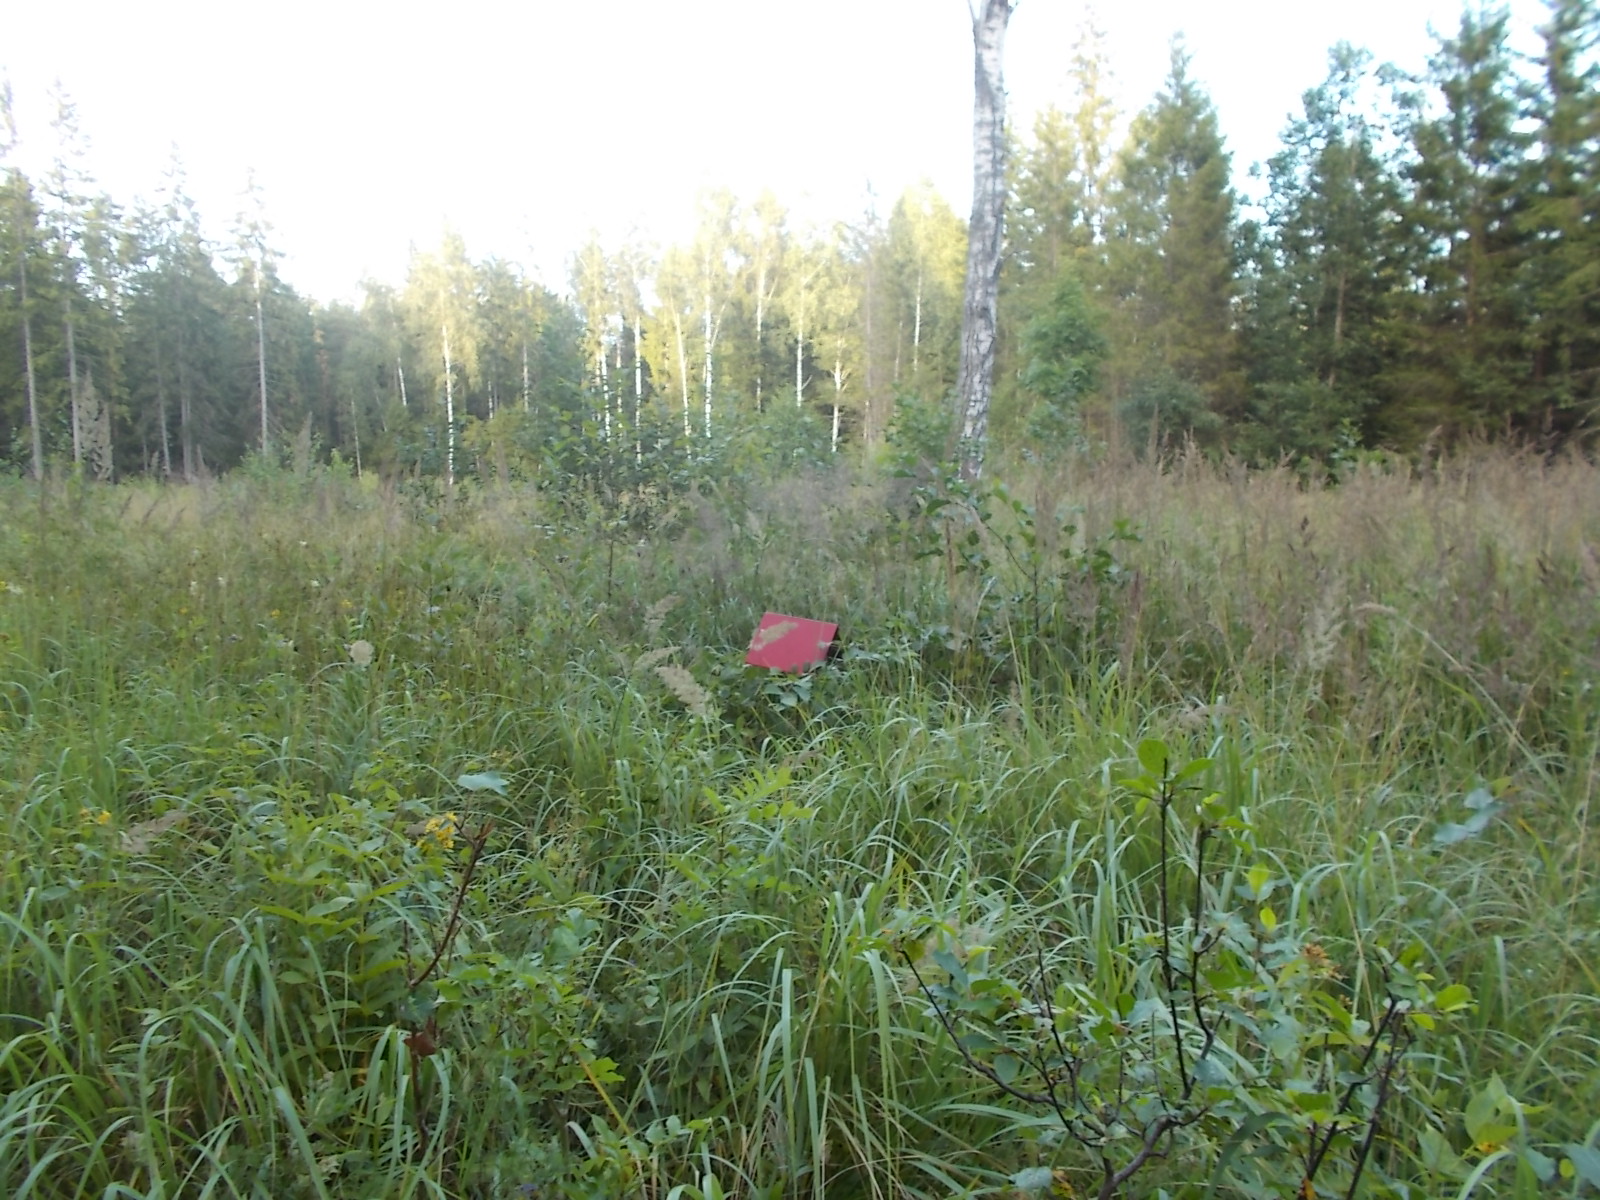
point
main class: Grassland
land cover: Grassland with sparse tree/shrub cover
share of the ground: > 75 %
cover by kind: herbaceous plants 90 %, broadleaved forest trees 5 %, shrubs 5 %
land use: Forestry
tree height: > 5 m
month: August
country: LV
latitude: 57.0895
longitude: 22.0783
